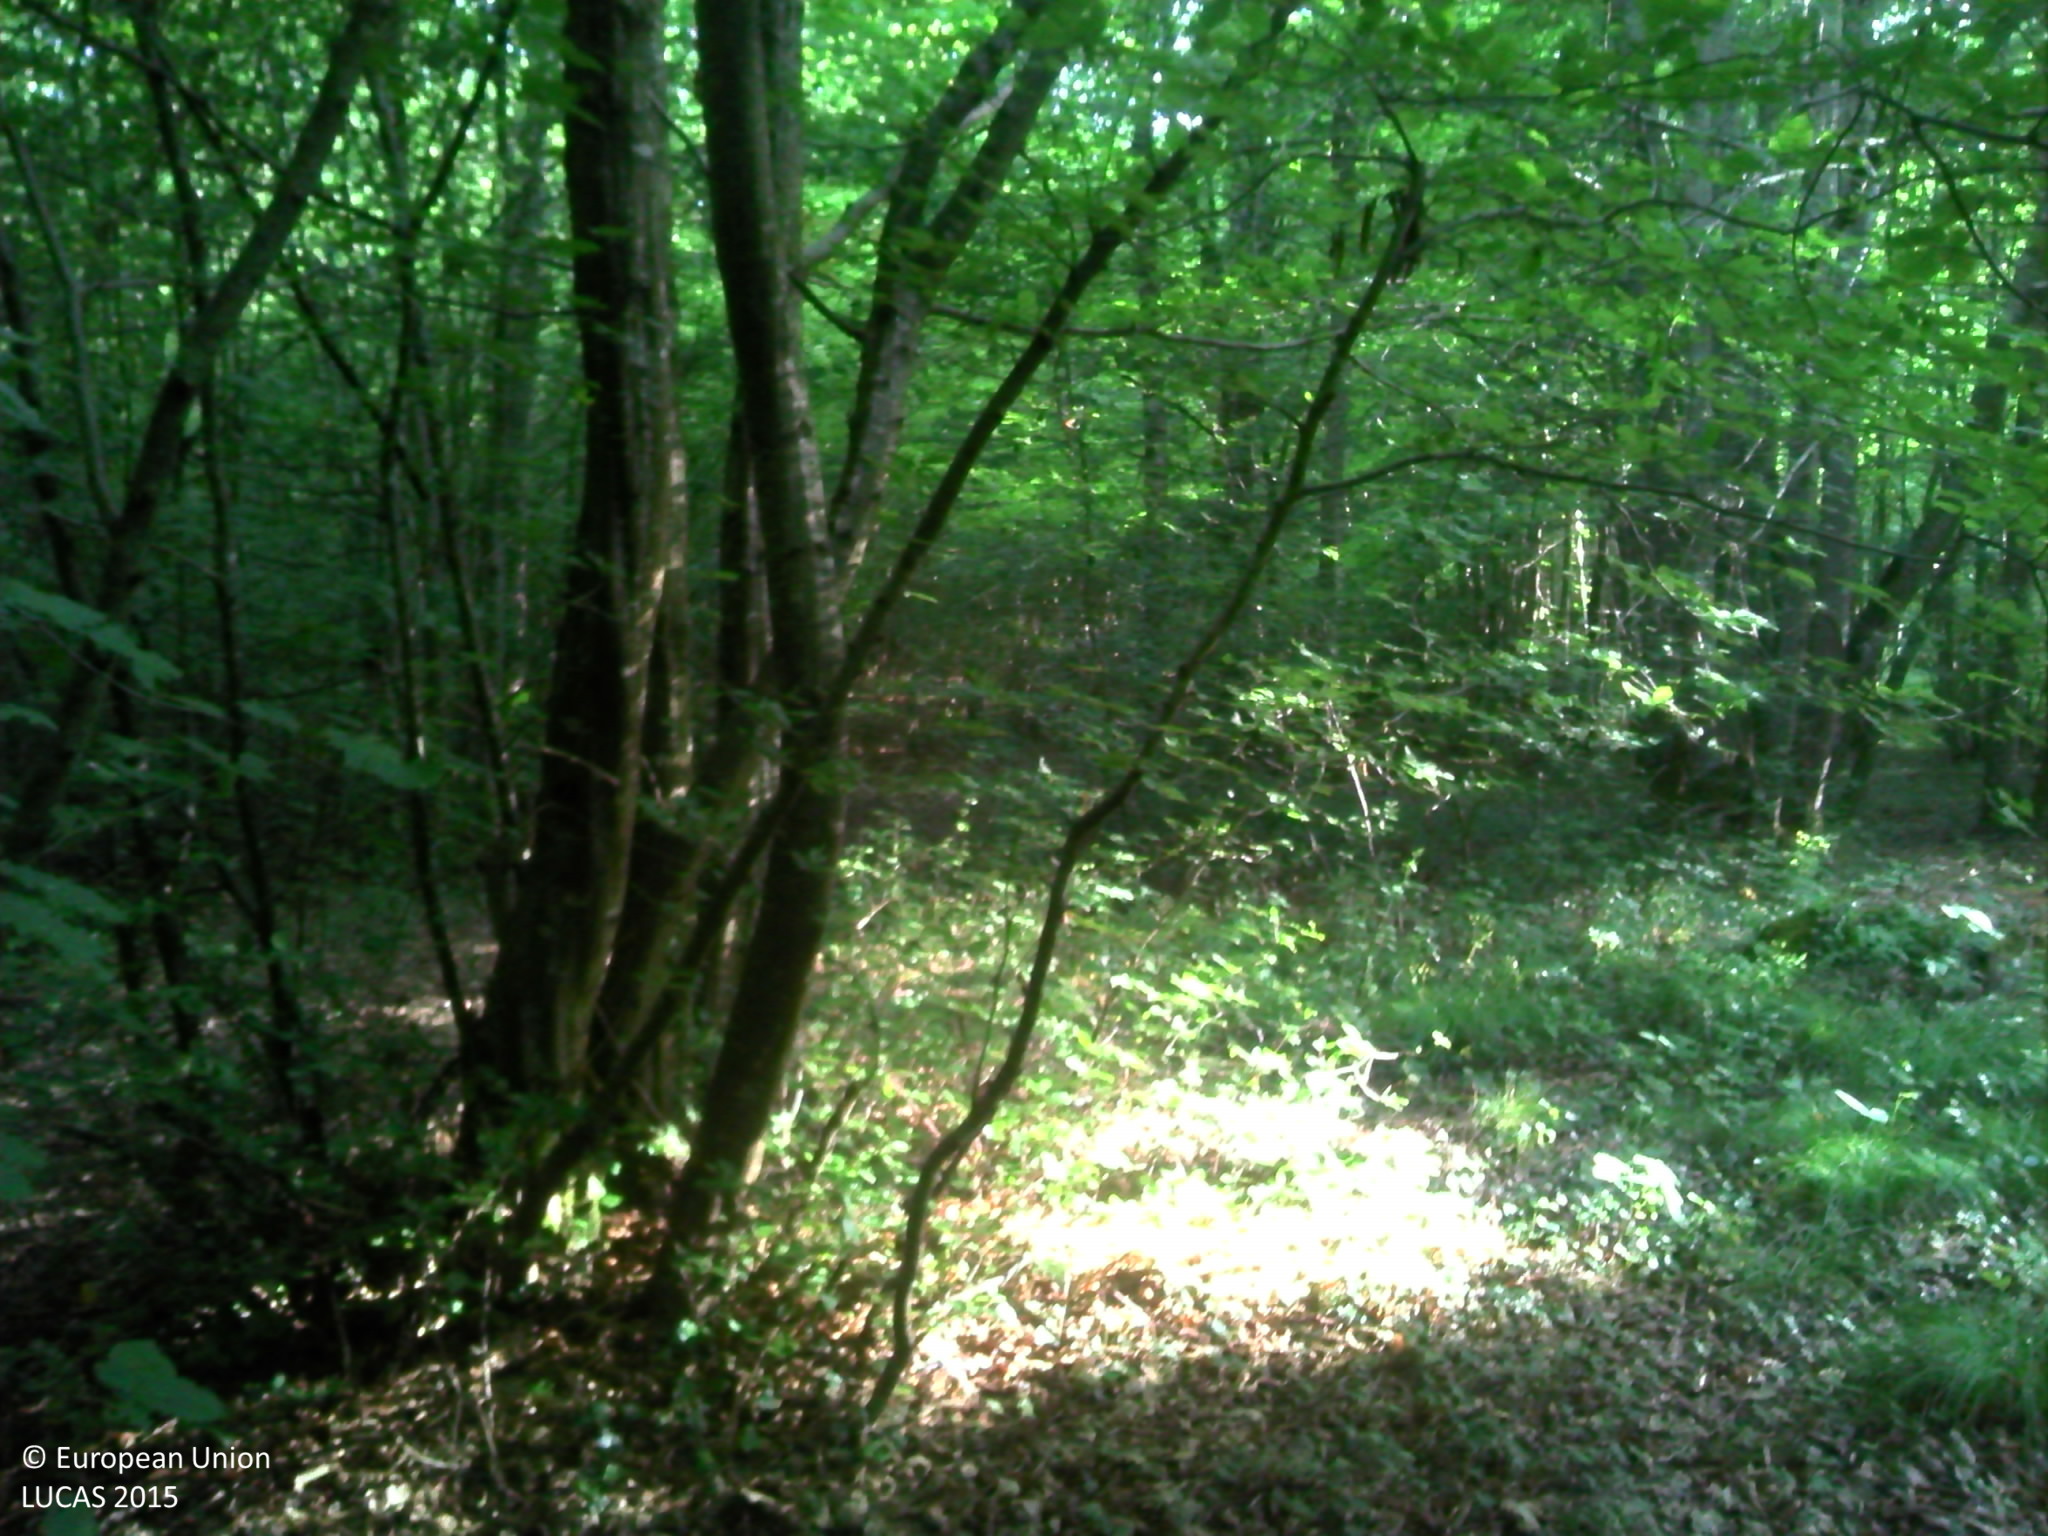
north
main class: Woodland
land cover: Broadleaved woodland
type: mesophytic deciduous forest
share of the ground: > 75 %
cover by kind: broadleaved forest trees 80 %, herbaceous plants 20 %
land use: Forestry
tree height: > 5 m
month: June
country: FR
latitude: 46.7470
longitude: 4.7785
